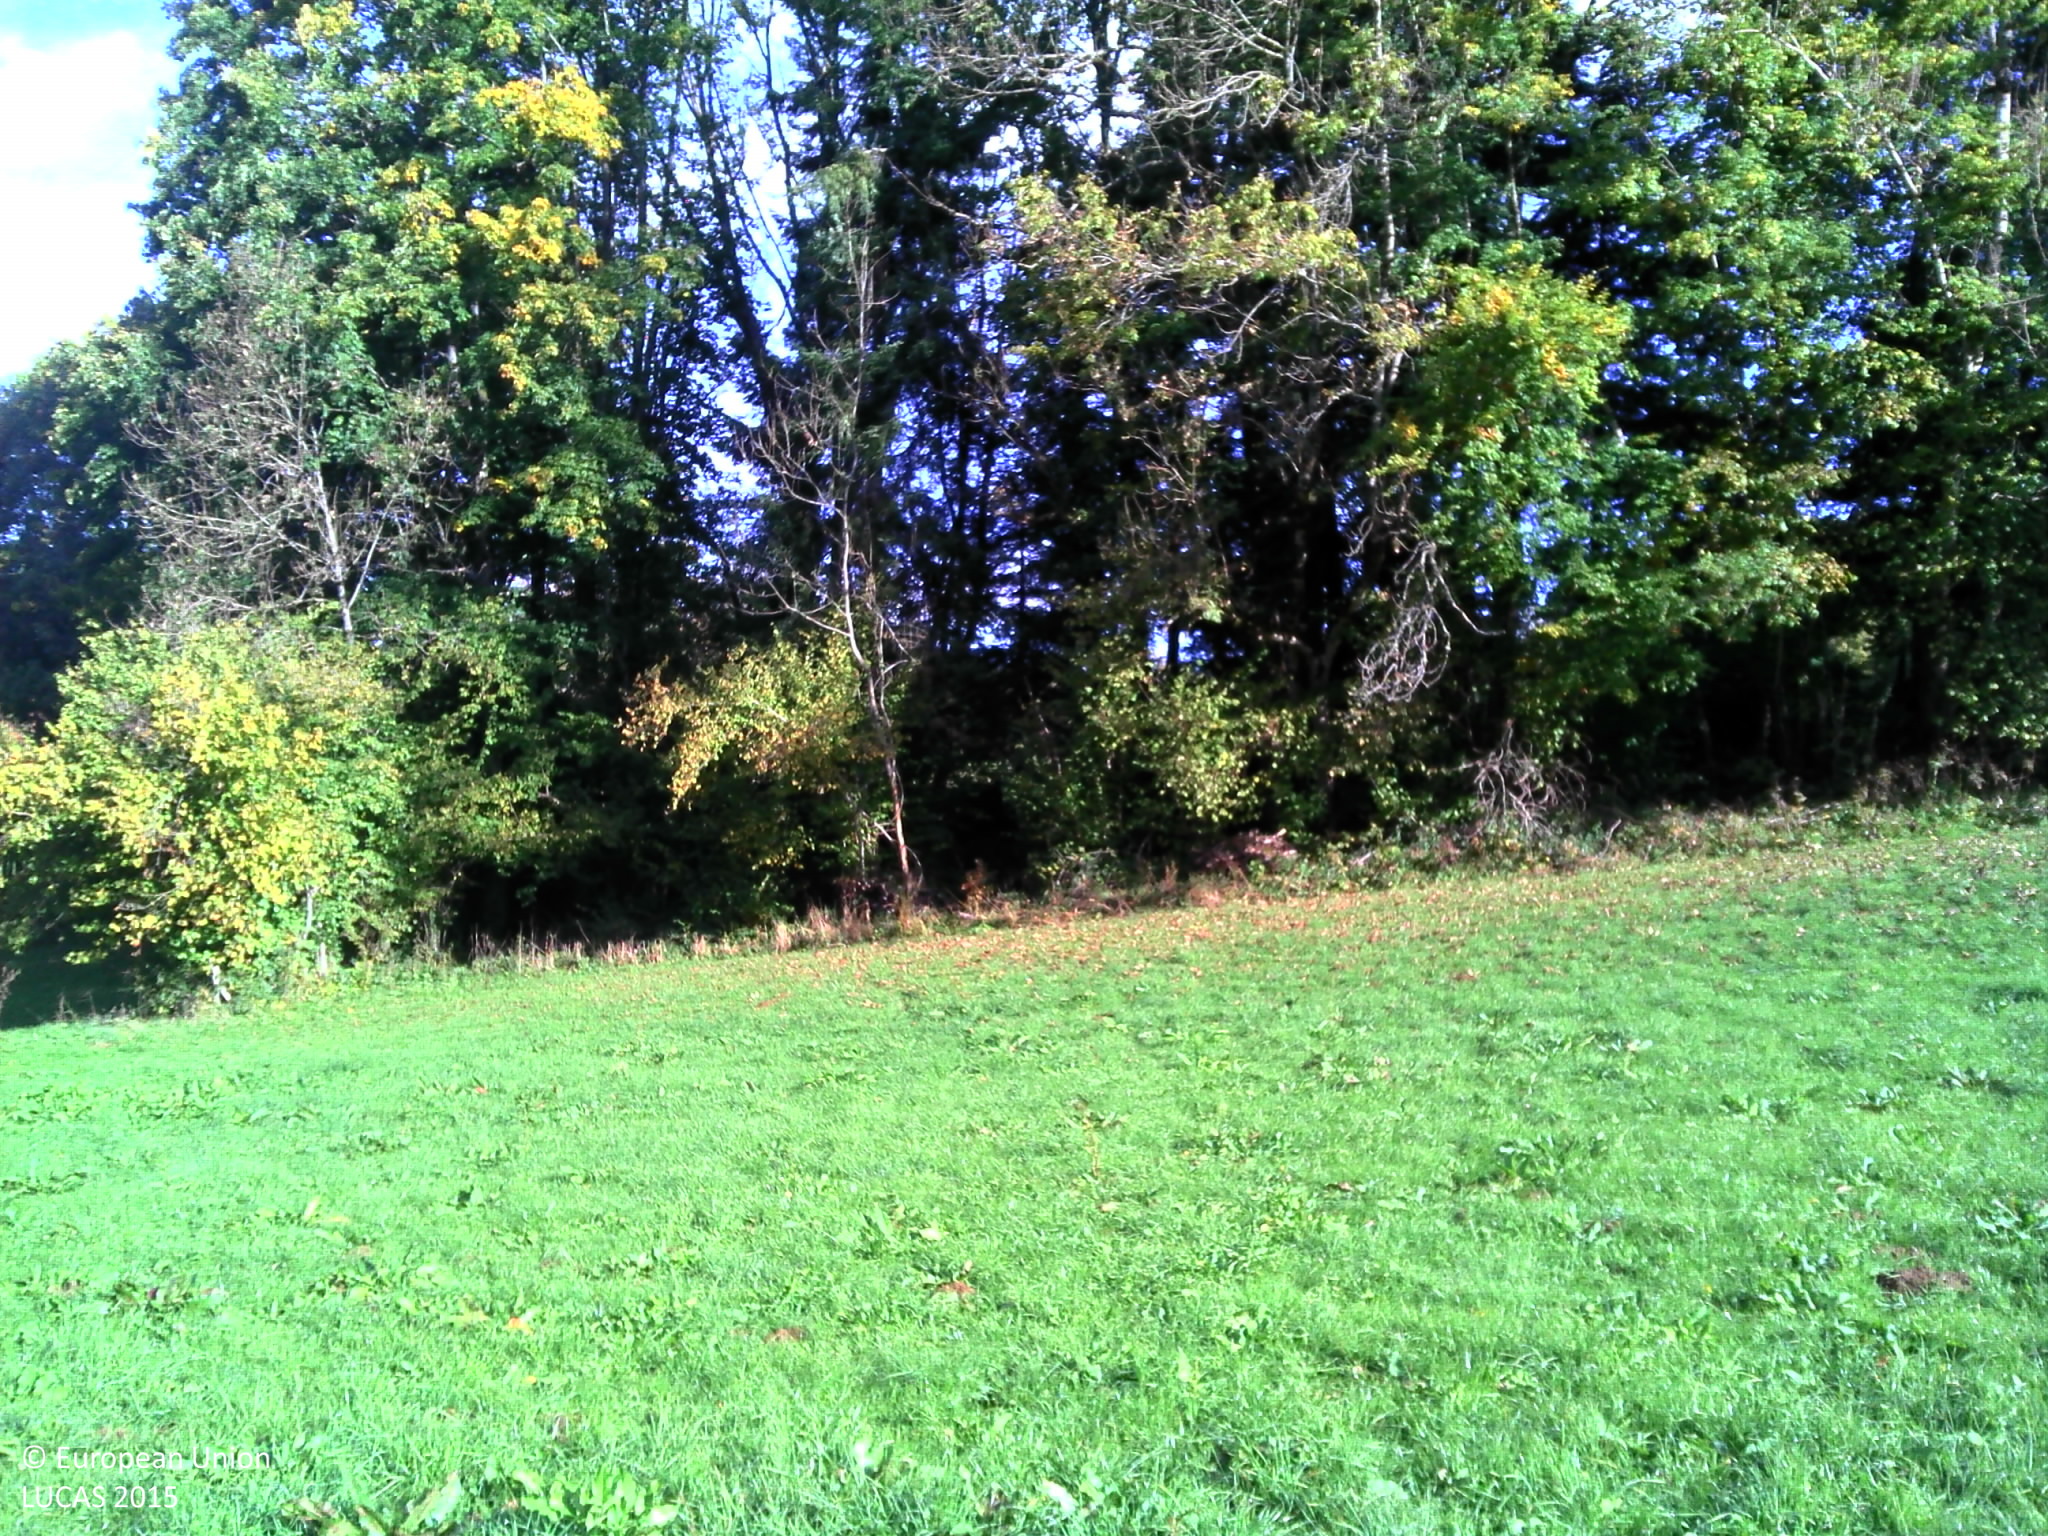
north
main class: Grassland
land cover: Grassland without tree/shrub cover
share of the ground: > 75 %
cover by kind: herbaceous plants 100 %
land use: Agriculture (excluding fallow land and kitchen gardens)
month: October
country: FR
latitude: 47.0642
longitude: 6.3549
